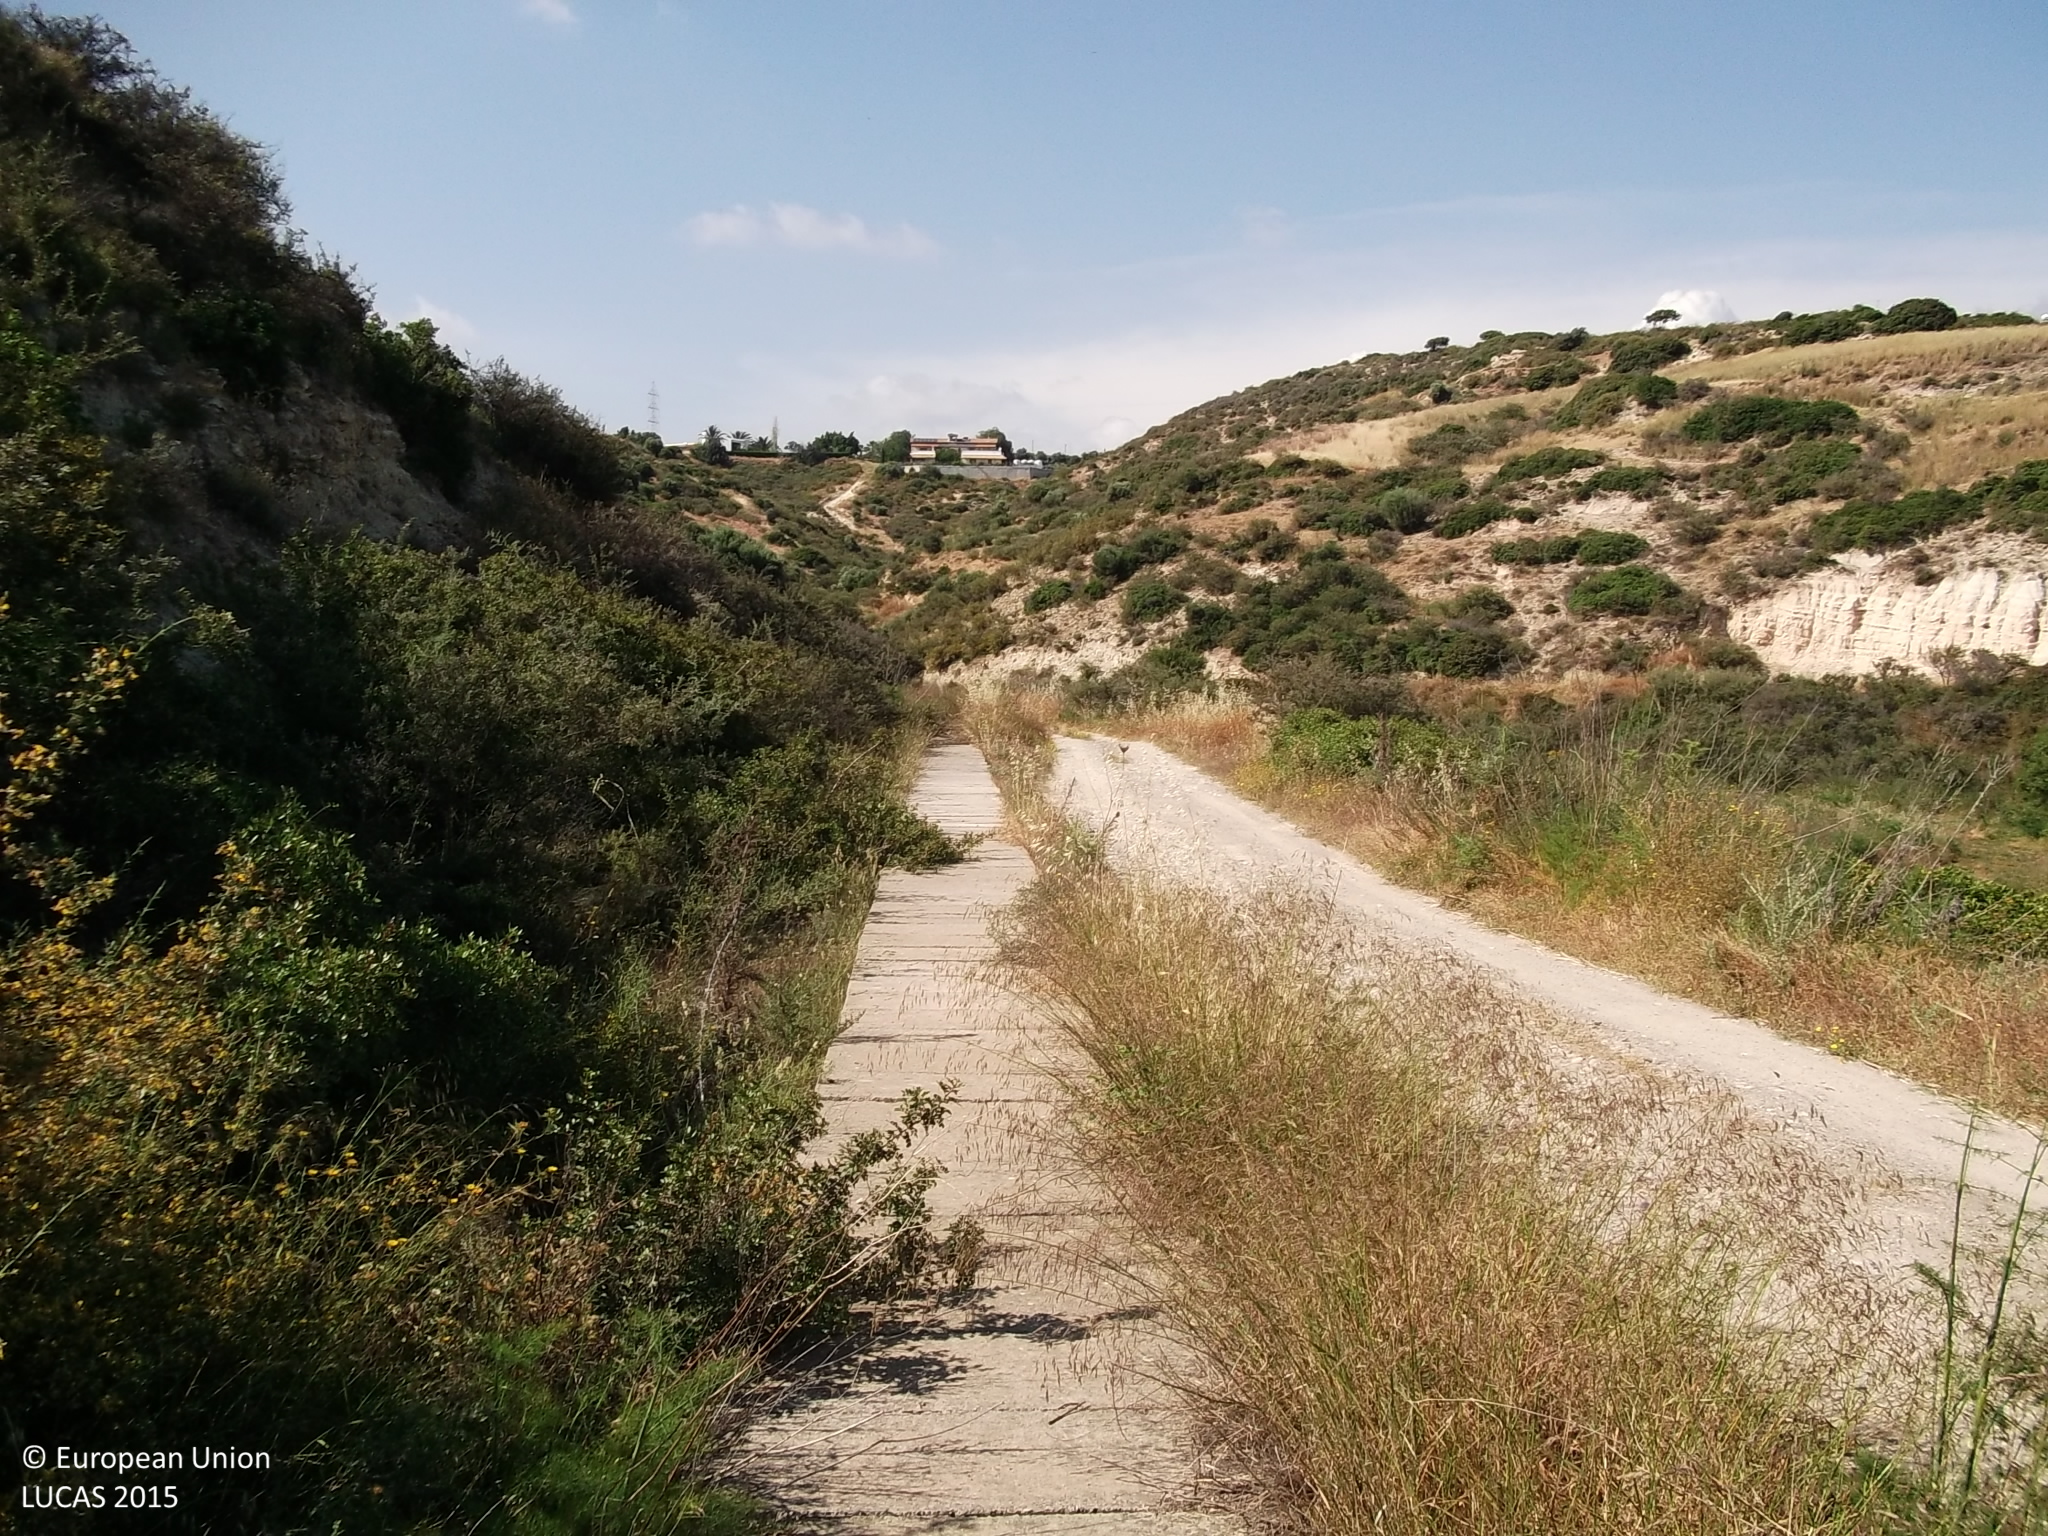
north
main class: Shrubland
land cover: Shrubland without tree cover
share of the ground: 50 - 75 %
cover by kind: shrubs 75 %, herbaceous plants 15 %, unconsolidated bare surface 10 %
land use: Semi-natural and natural areas not in use
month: May
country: CY
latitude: 34.7167
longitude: 32.5652
